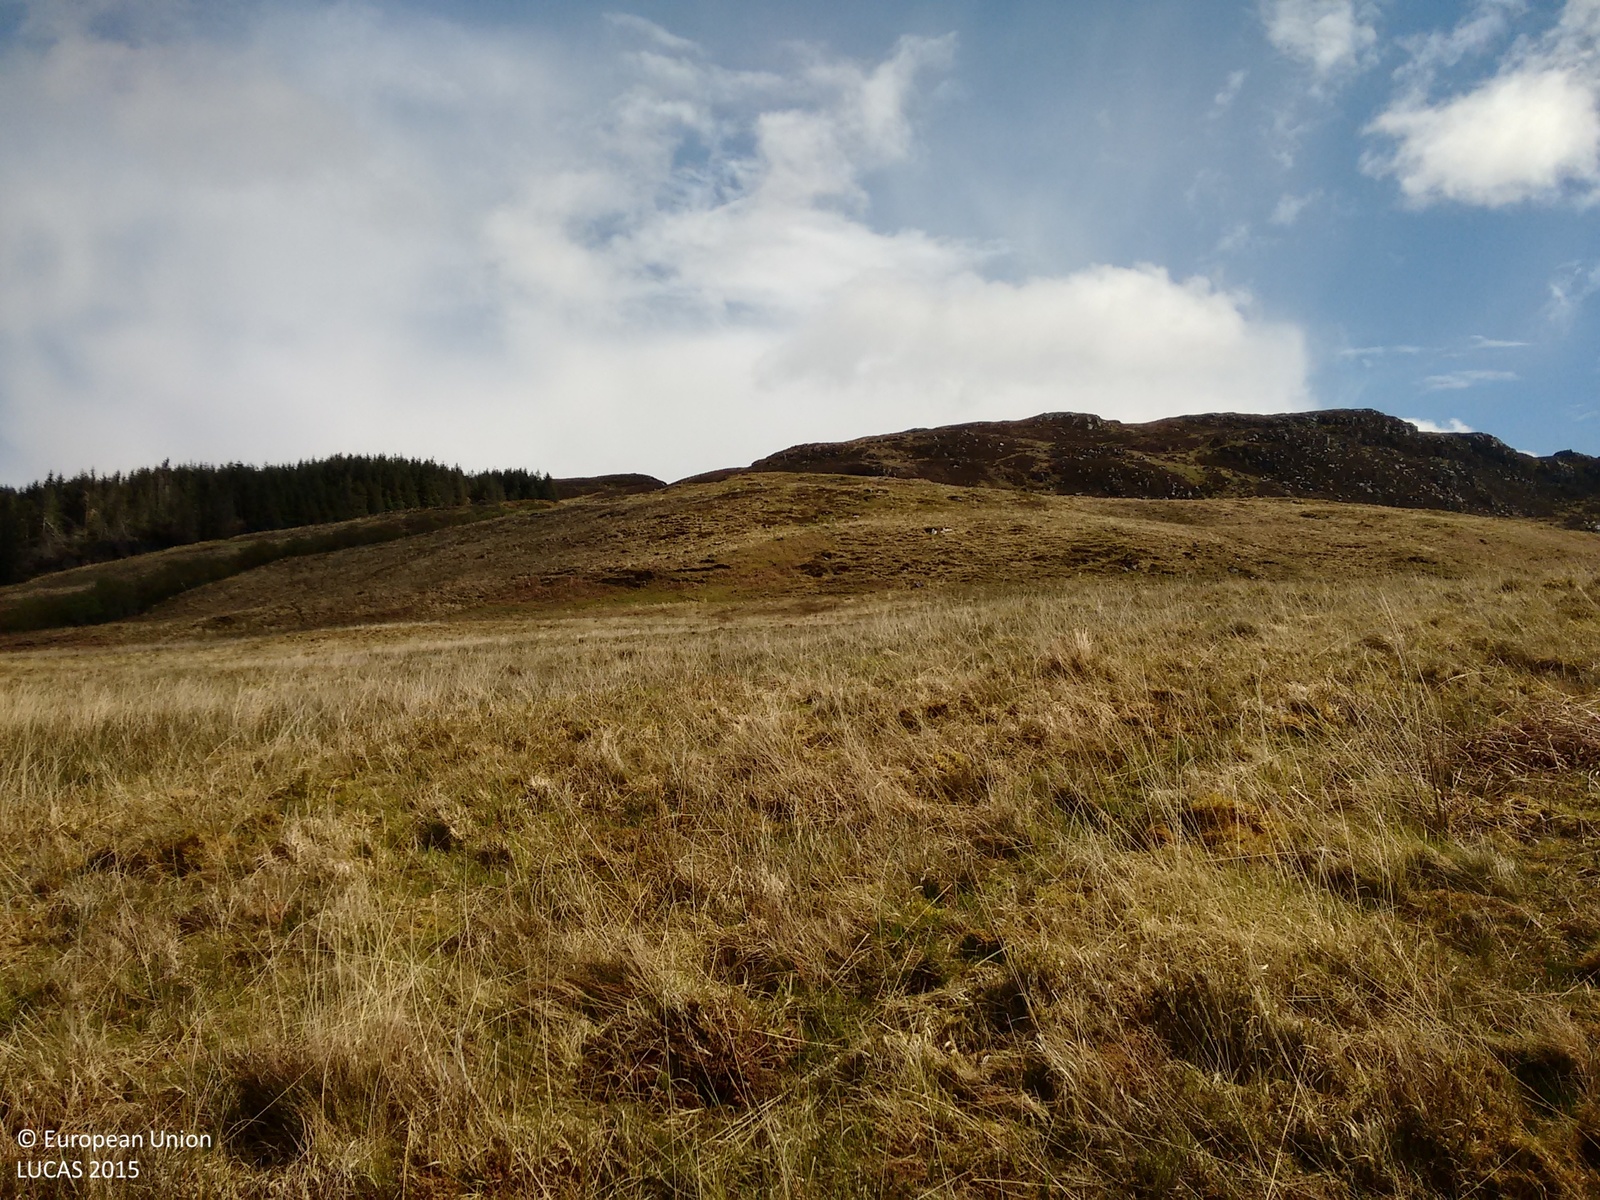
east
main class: Grassland
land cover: Grassland without tree/shrub cover
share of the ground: > 75 %
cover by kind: herbaceous plants 100 %
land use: Agriculture (excluding fallow land and kitchen gardens)
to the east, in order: Grassland without tree/shrub cover
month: May
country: GB
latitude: 55.9759
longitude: -5.1612
